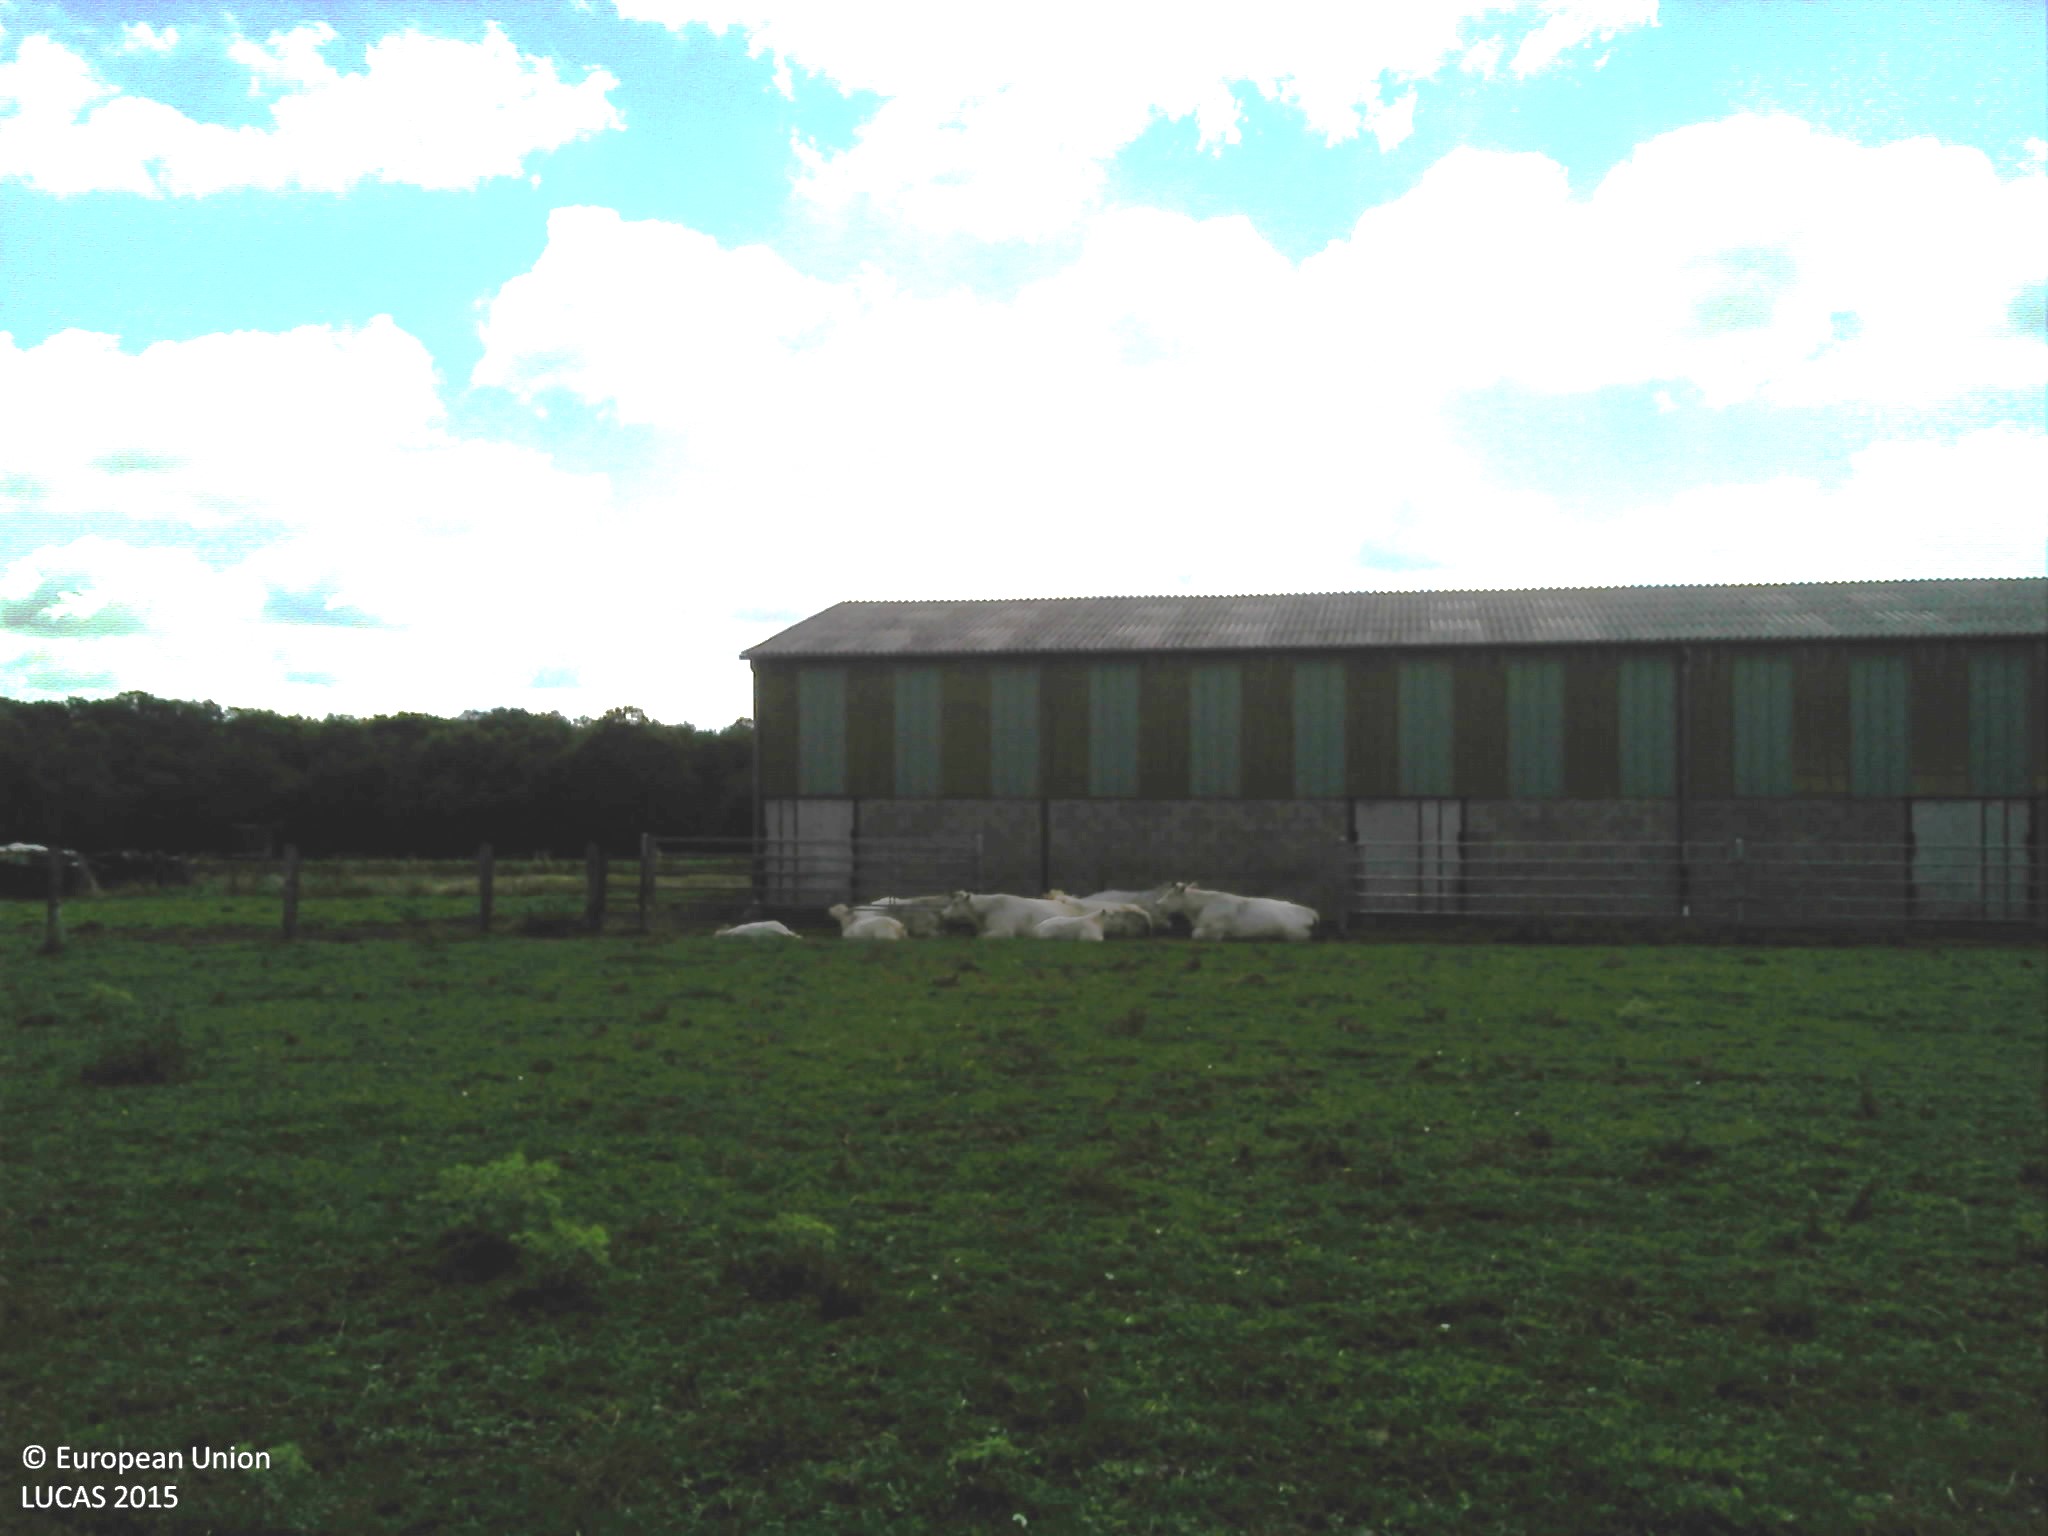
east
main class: Grassland
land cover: Grassland without tree/shrub cover
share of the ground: > 75 %
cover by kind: herbaceous plants 100 %
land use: Agriculture (excluding fallow land and kitchen gardens)
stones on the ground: < 10 %
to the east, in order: Grassland without tree/shrub cover; Artificial constructions in urban areas; Maize; Fences; Tracks; Fences; Broadleaved woodland; Rivers and streams; Grassland without tree/shrub cover; Rivers and streams; Grassland without tree/shrub cover
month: June
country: FR
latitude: 46.7180
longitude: 3.5749
